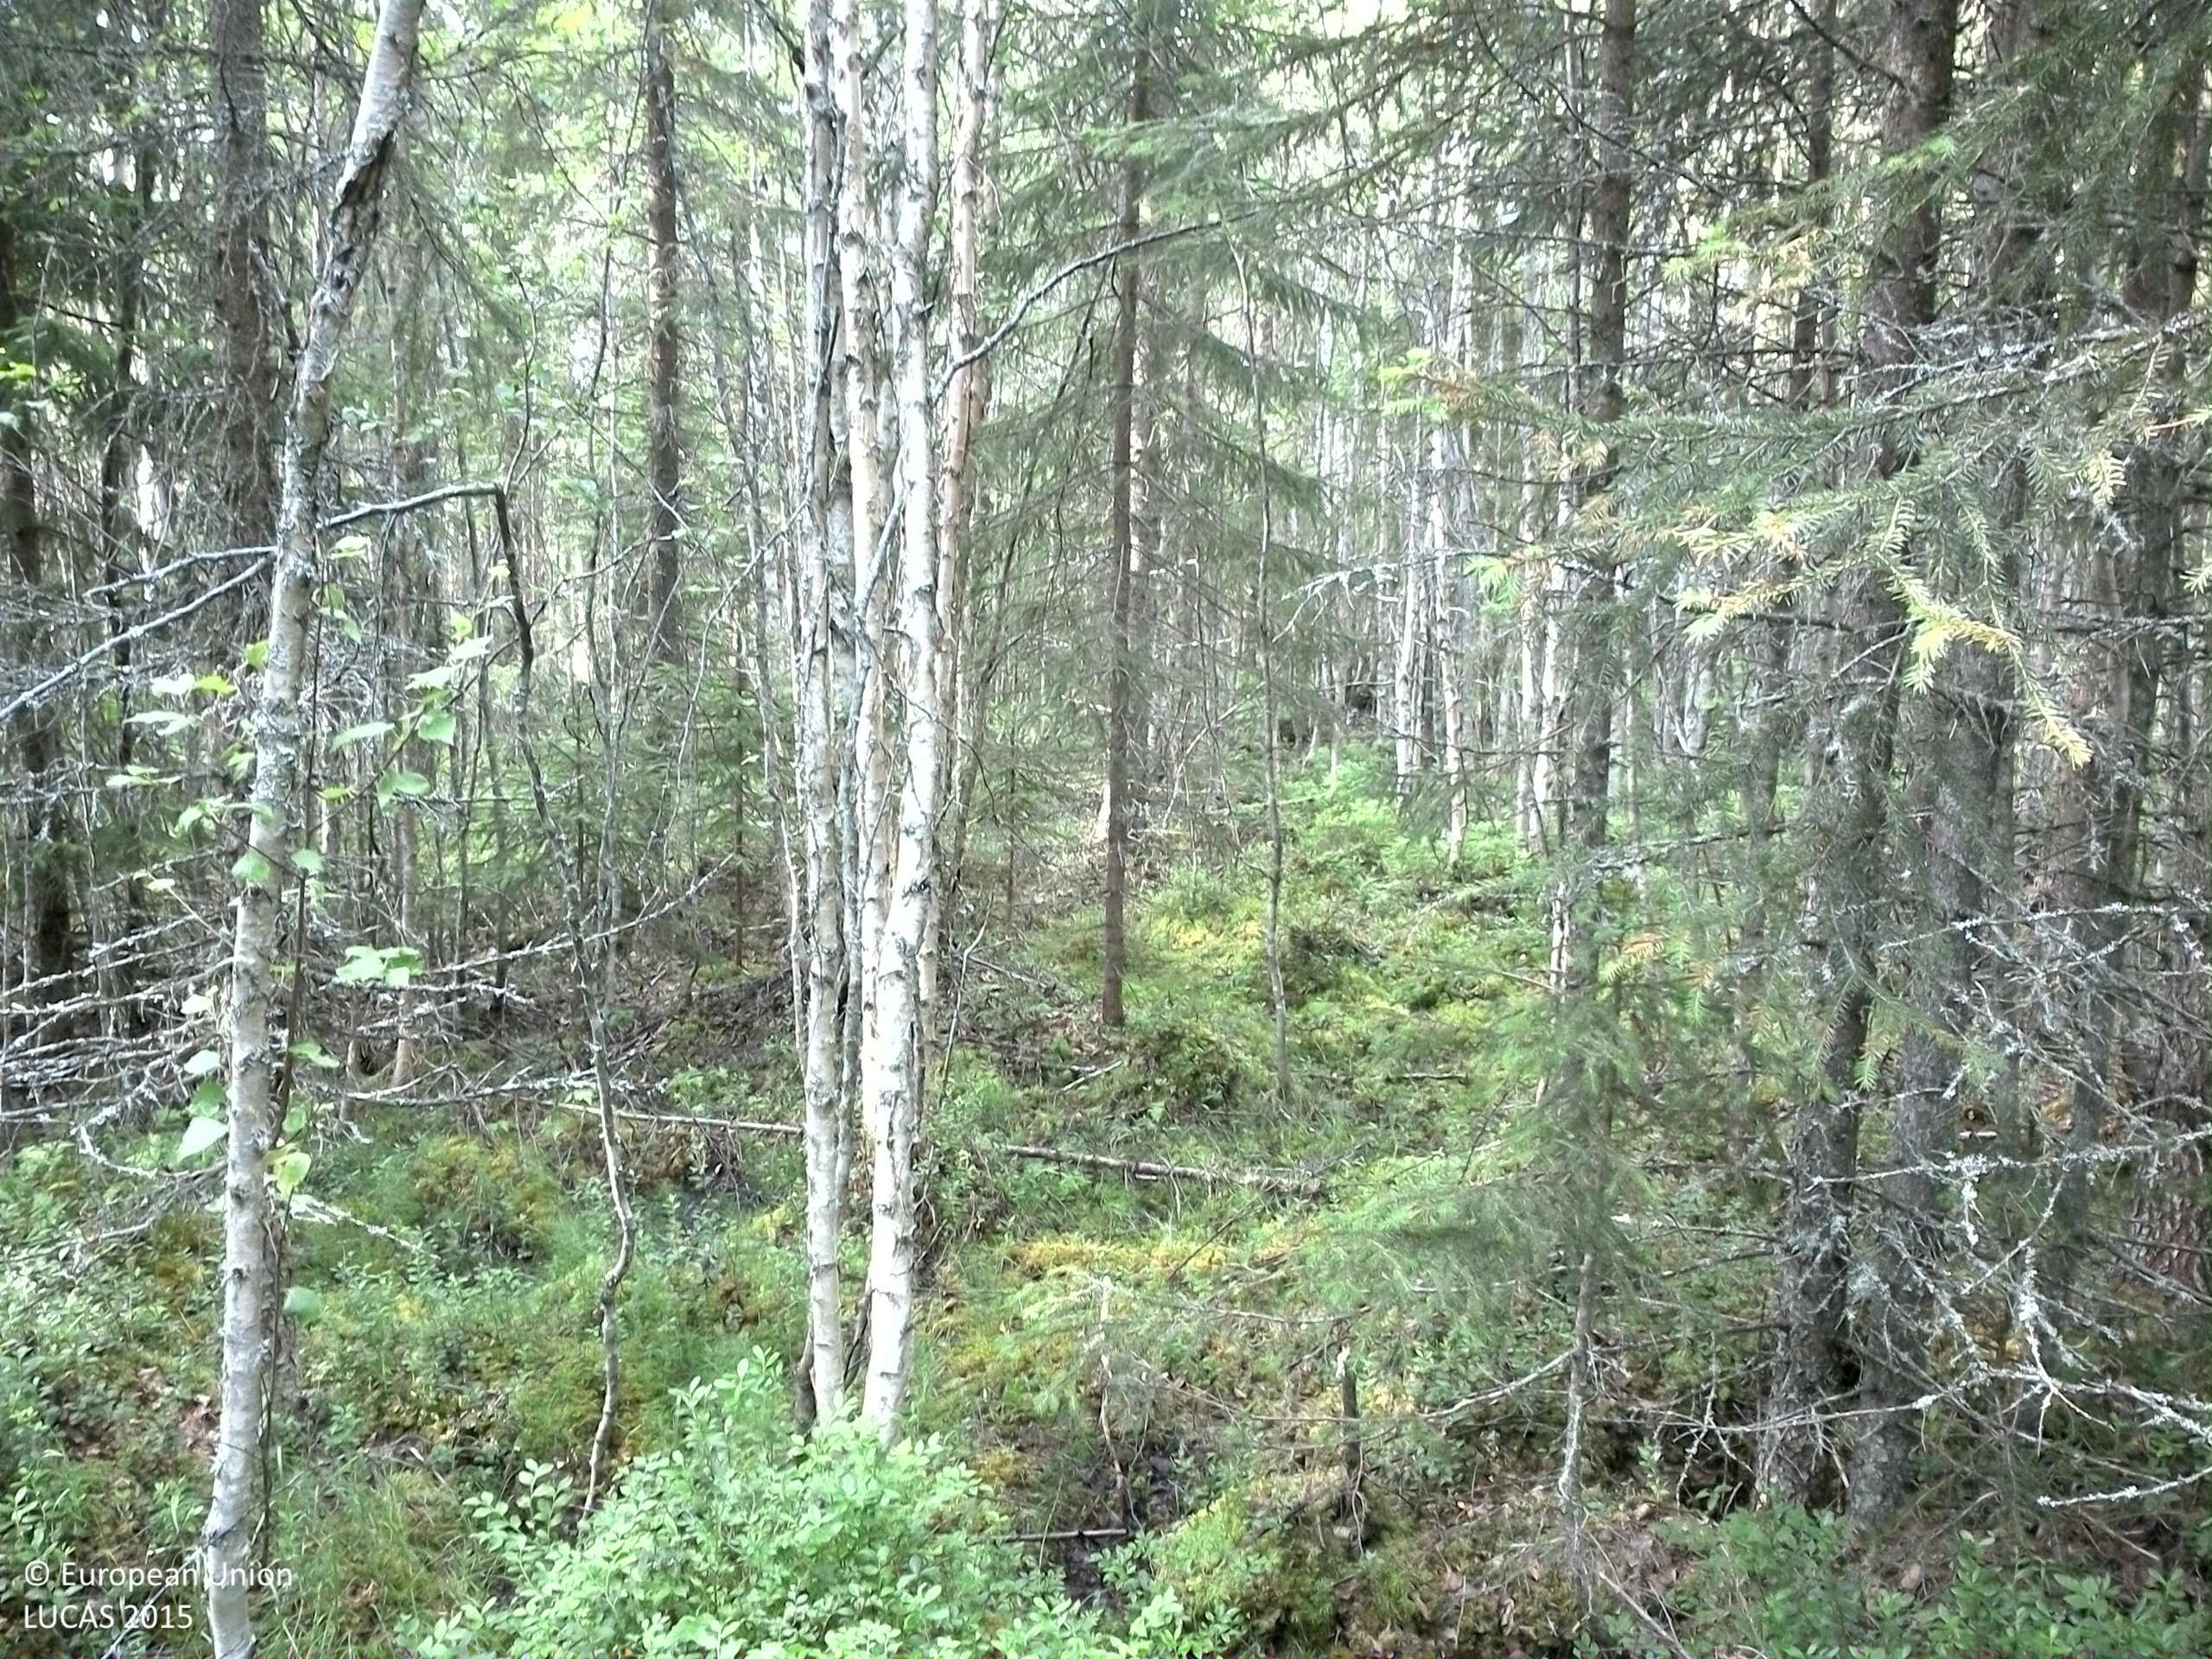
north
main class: Woodland
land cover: Spruce dominated mixed woodland
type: boreal forest
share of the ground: 50 - 75 %
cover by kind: coniferous forest trees 45 %, broadleaved forest trees 25 %, shrubs 10 %, herbaceous plants 10 %, lichens and mosses 10 %
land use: Forestry
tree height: > 5 m
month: August
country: SE
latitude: 63.5868
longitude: 16.6828
